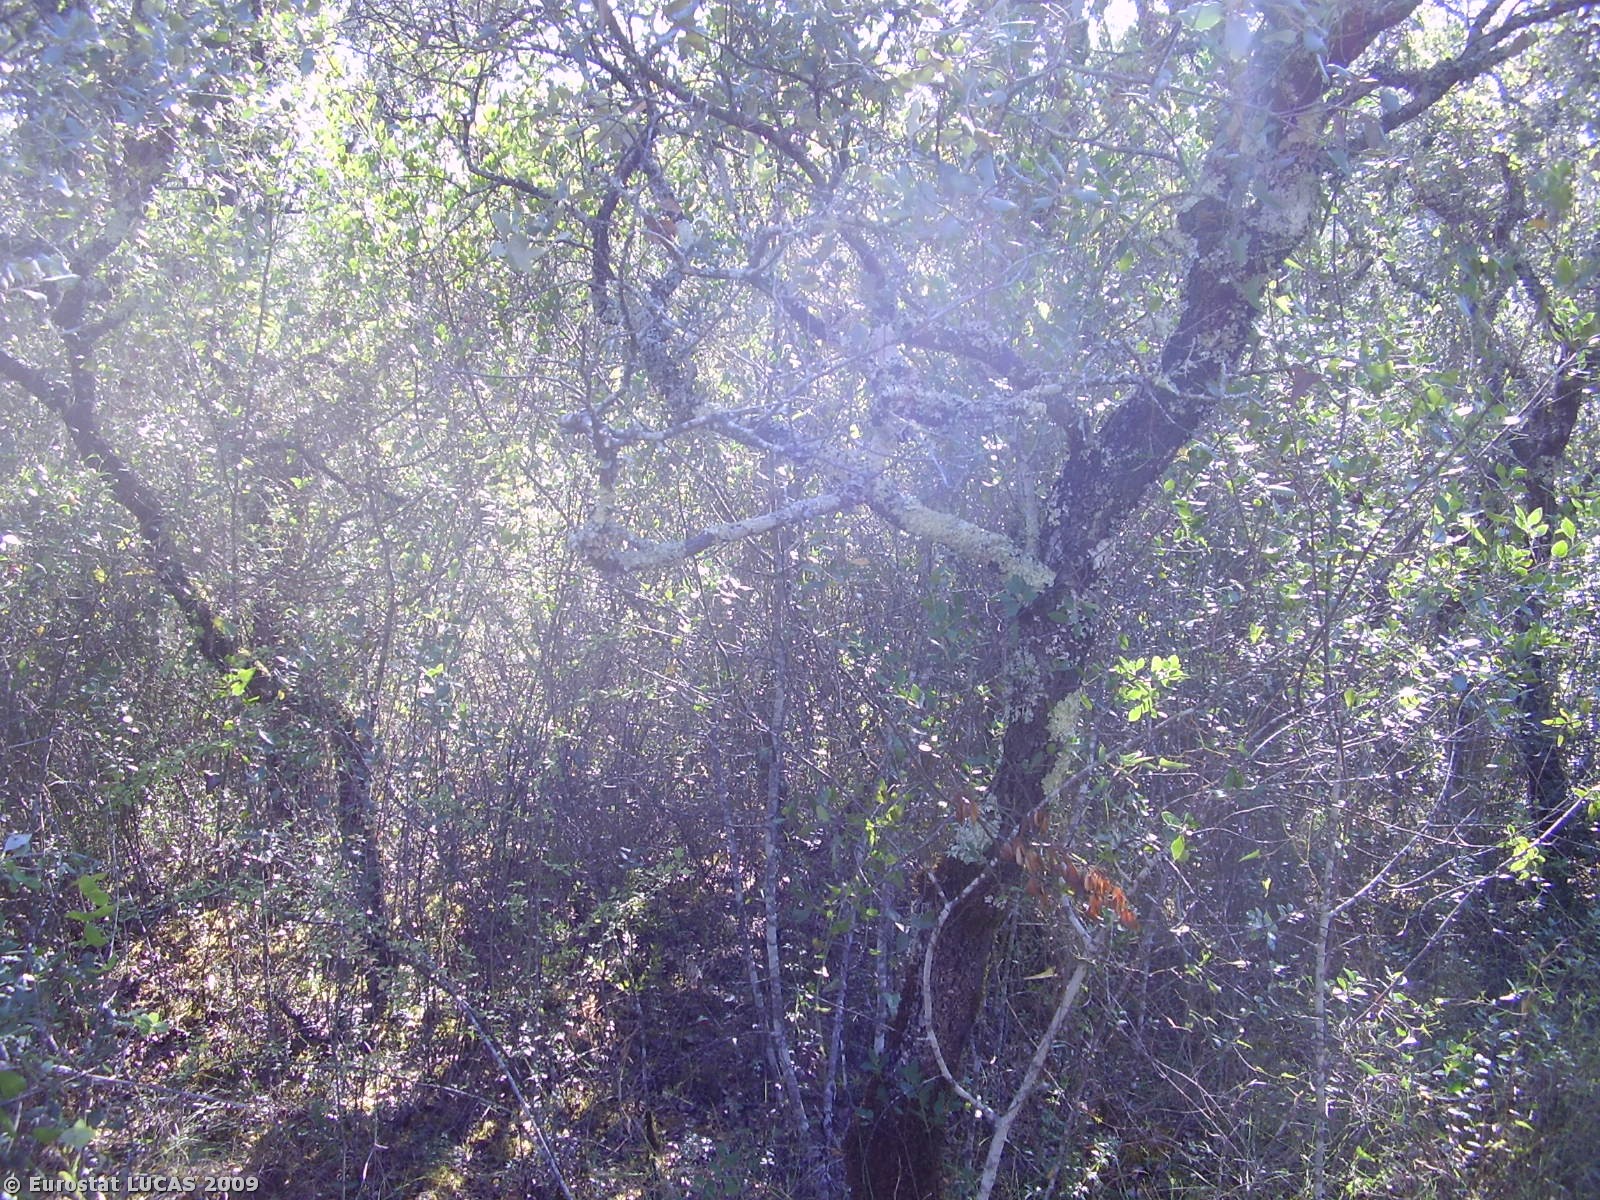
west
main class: Woodland
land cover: Broadleaved woodland
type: broadleaved evergreen forest
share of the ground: 50 - 75 %
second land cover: Shrubland with sparse tree cover
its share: 25 - 50 %
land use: Forestry
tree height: > 5 m
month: July
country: PT
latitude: 39.6558
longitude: -8.4062
